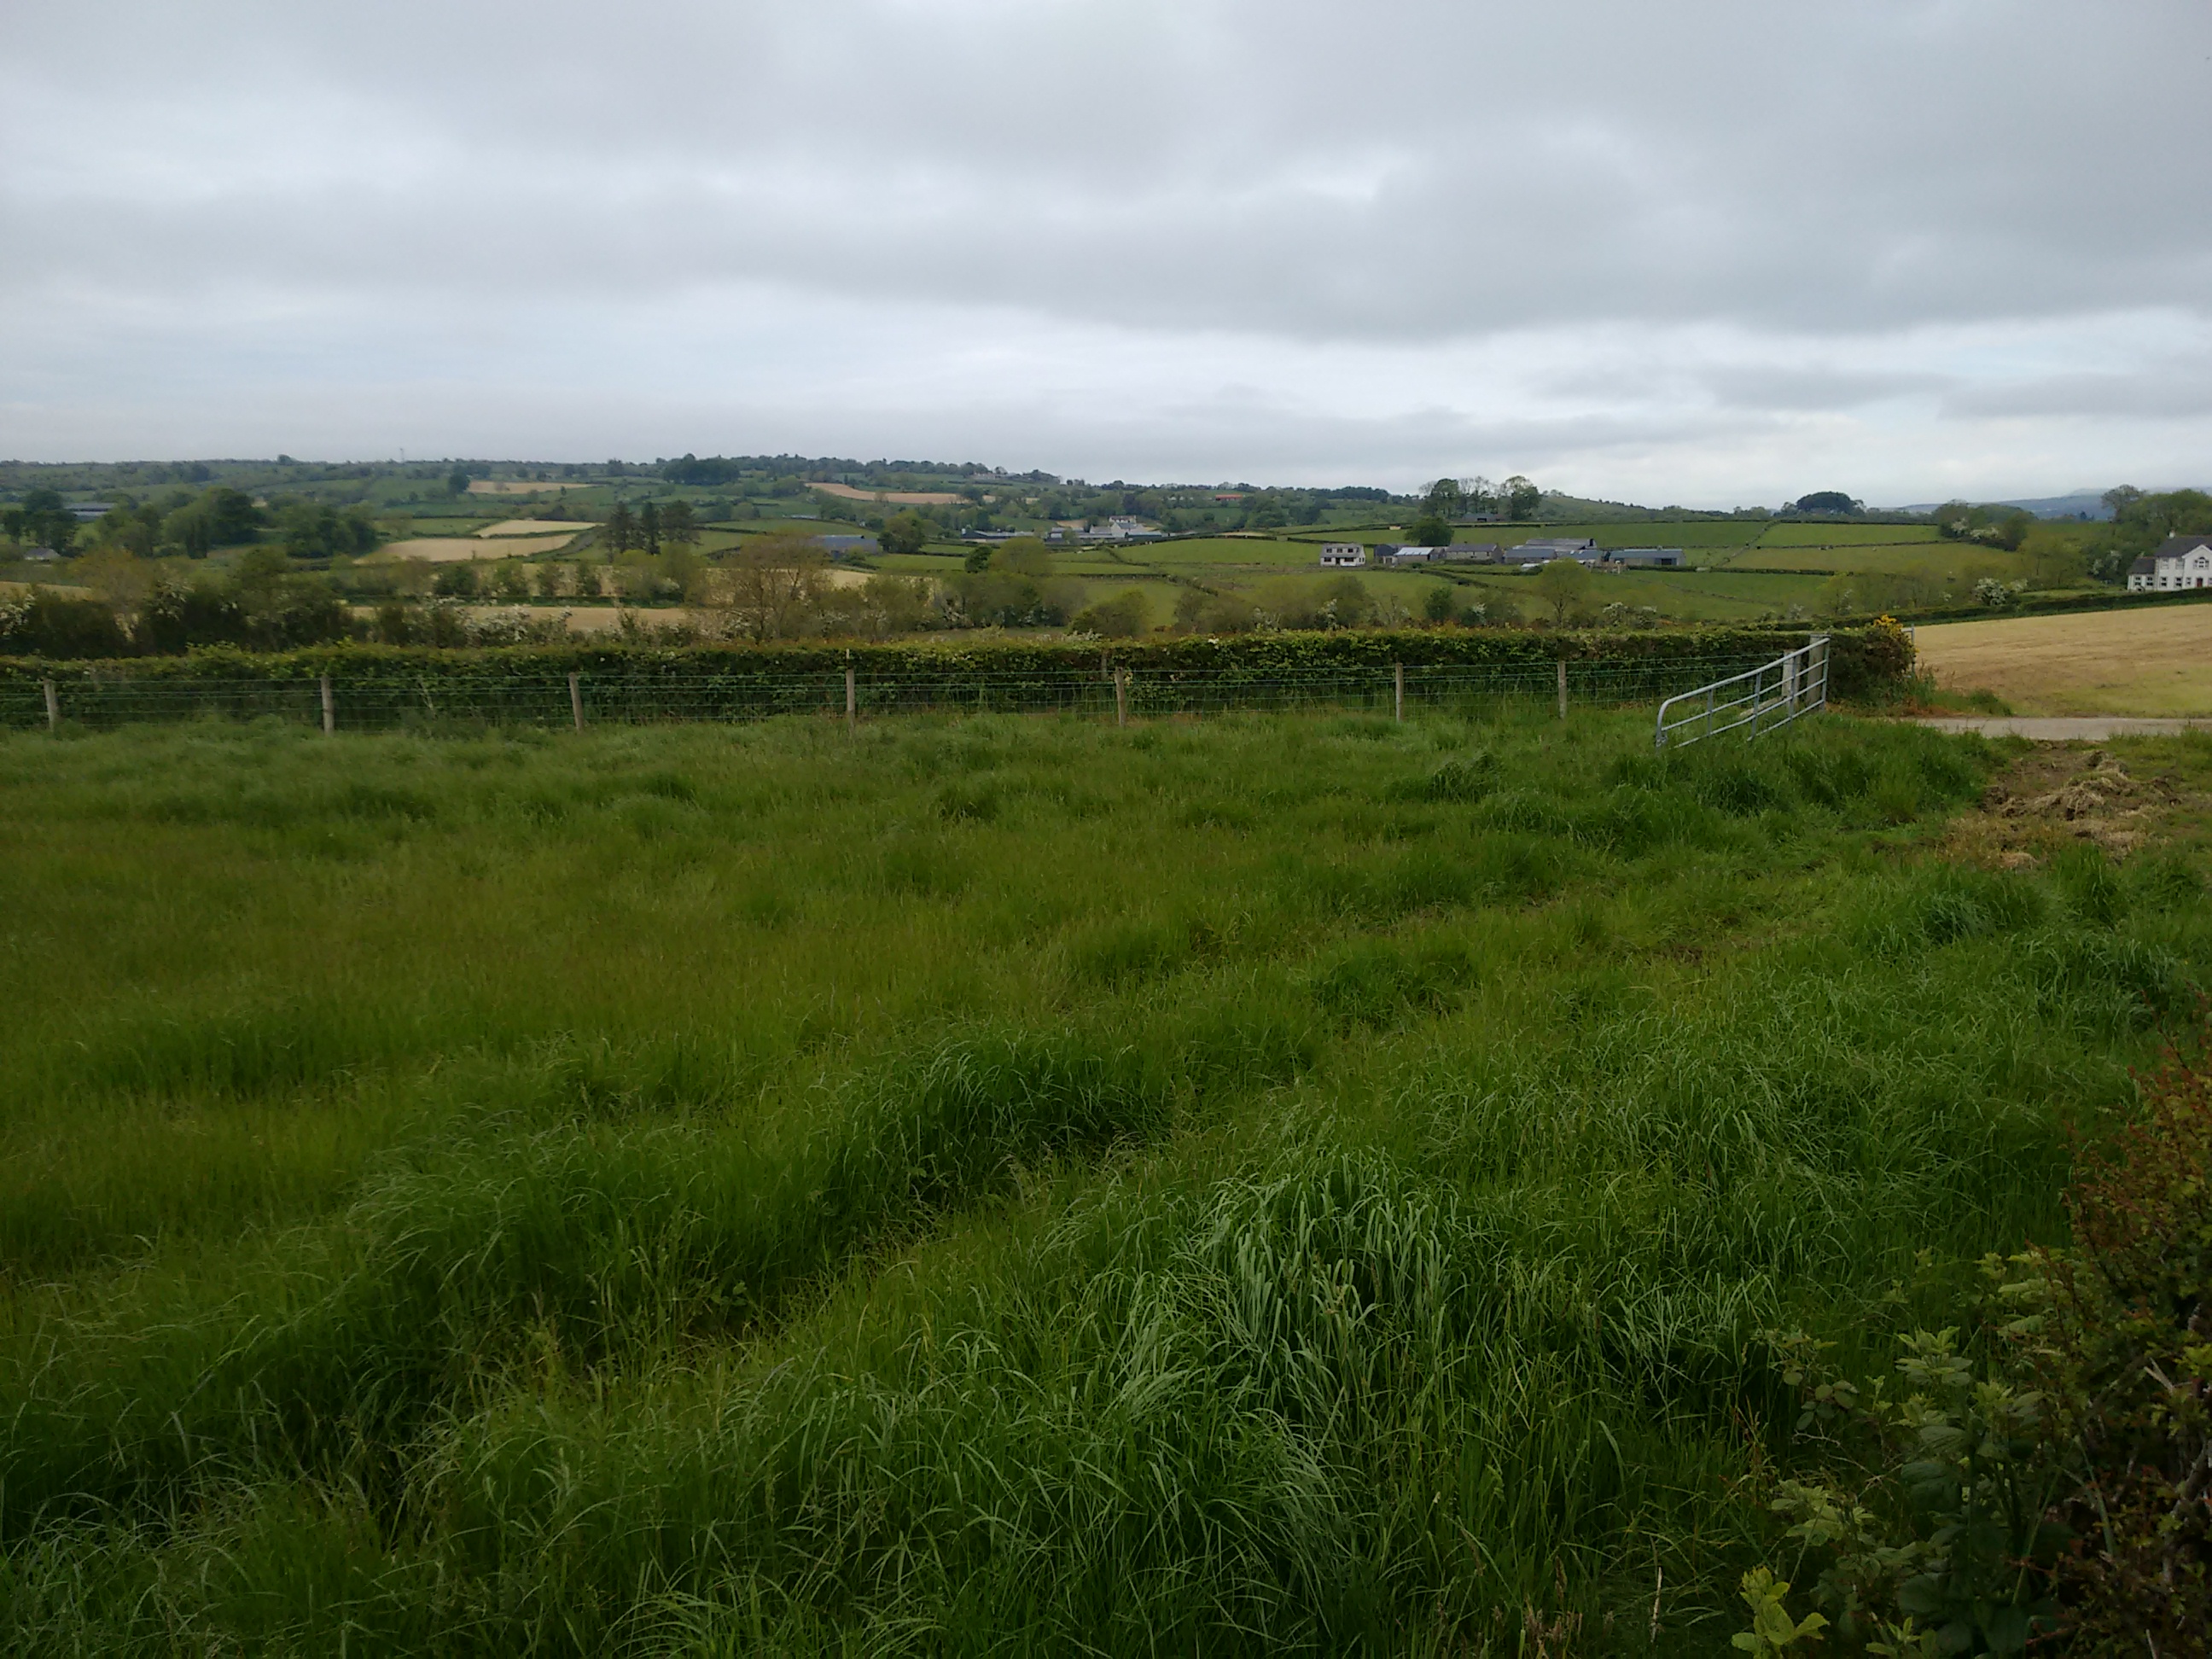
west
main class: Grassland
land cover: Grassland without tree/shrub cover
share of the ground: > 75 %
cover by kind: herbaceous plants 100 %
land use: Agriculture (excluding fallow land and kitchen gardens)
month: June
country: GB
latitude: 54.9572
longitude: -6.6654
